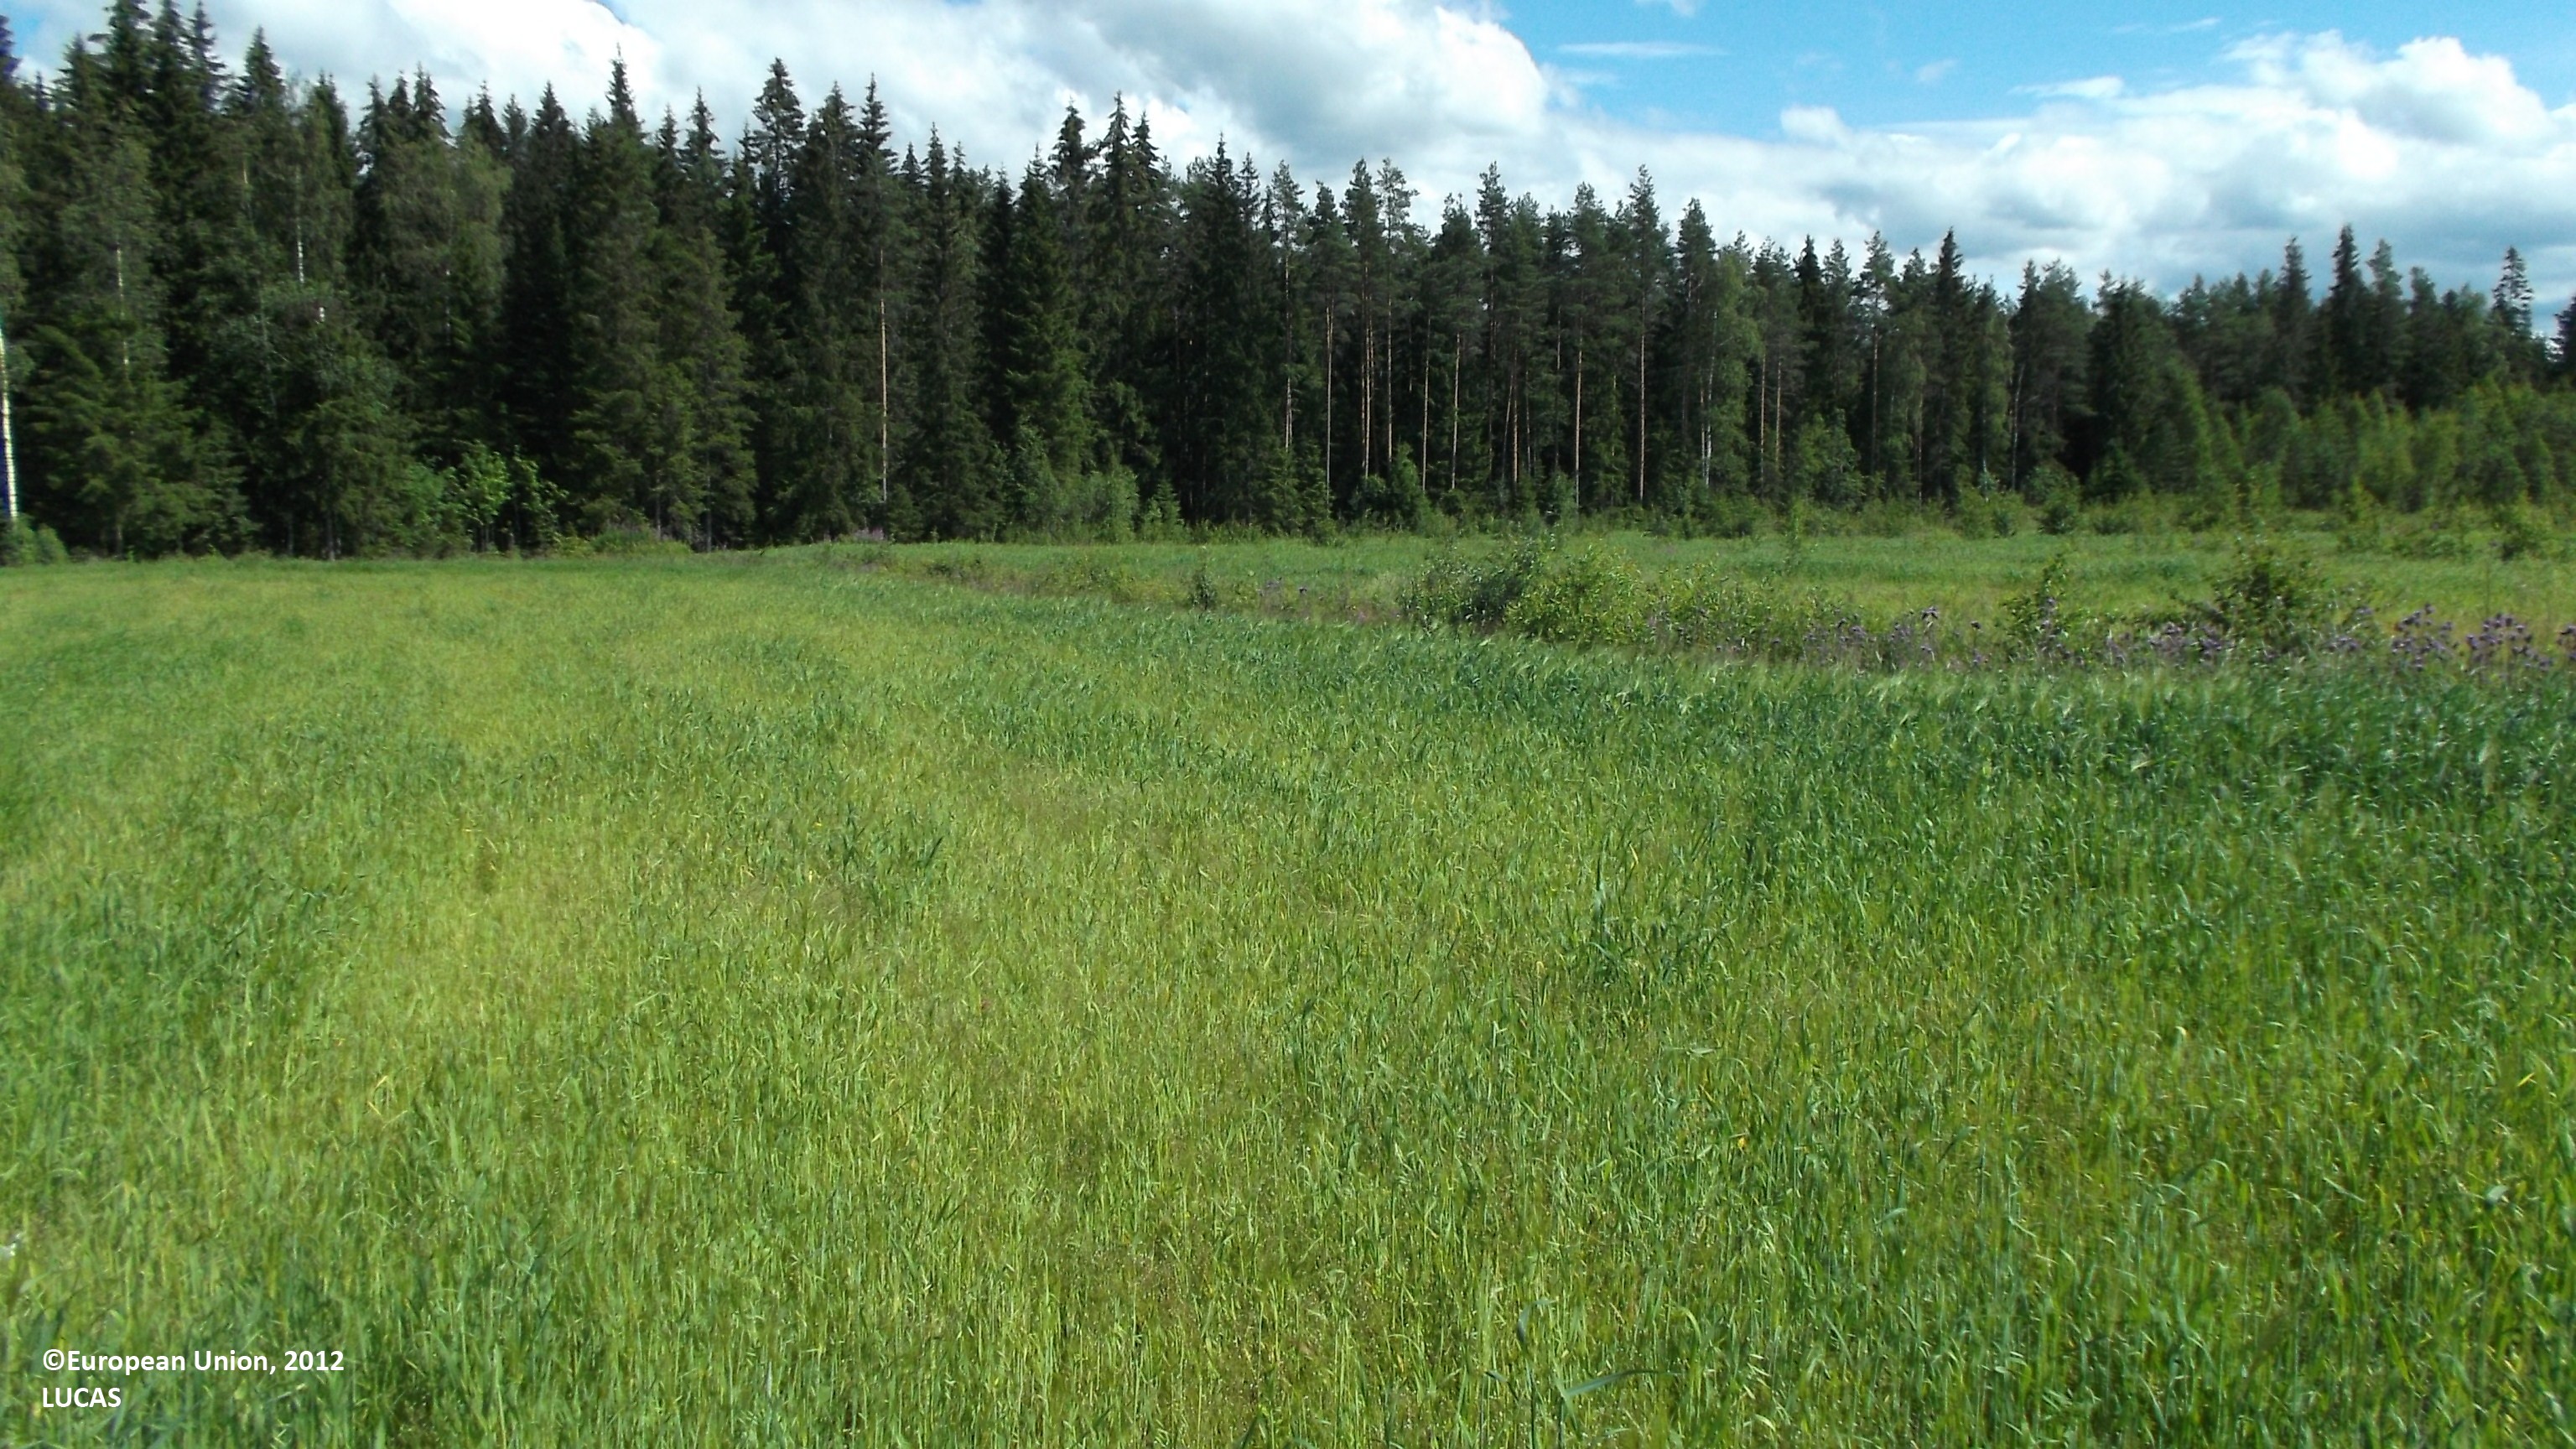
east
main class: Grassland
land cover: Grassland without tree/shrub cover
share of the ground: 25 - 50 %
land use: Fallow land
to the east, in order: Grassland without tree/shrub cover; Ditches and canals; Grassland without tree/shrub cover; Ditches and canals; Grassland without tree/shrub cover; Abandoned hedges; Ditches and canals; Abandoned hedges; Grassland without tree/shrub cover; Abandoned hedges; Ditches and canals; Grassland without tree/shrub cover; Shrubland without tree cover; Ditches and canals; Other mixed woodland; Ditches and canals; Spruce dominated mixed woodland; Spruce dominated coniferous woodland
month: July
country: FI
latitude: 63.3259
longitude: 23.8667
